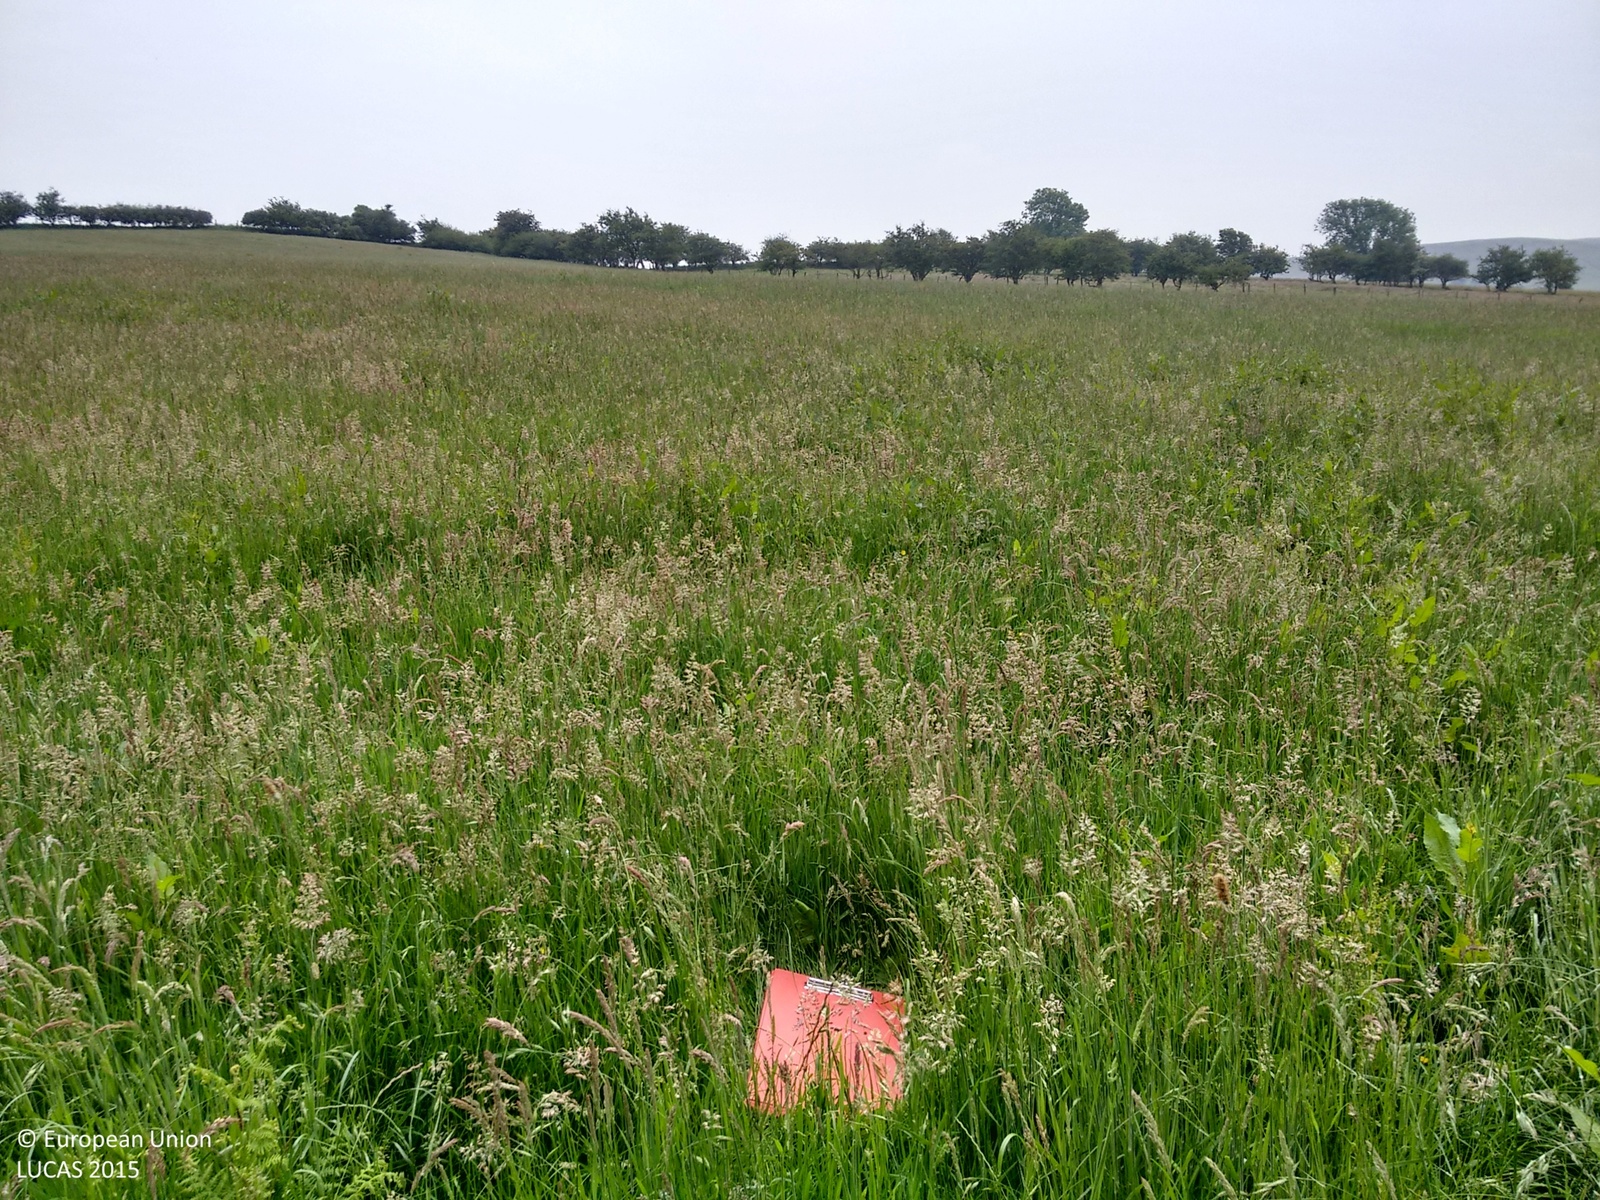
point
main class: Grassland
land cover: Grassland without tree/shrub cover
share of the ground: > 75 %
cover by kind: herbaceous plants 100 %
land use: Agriculture (excluding fallow land and kitchen gardens)
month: June
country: GB
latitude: 54.3925
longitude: -1.1480
